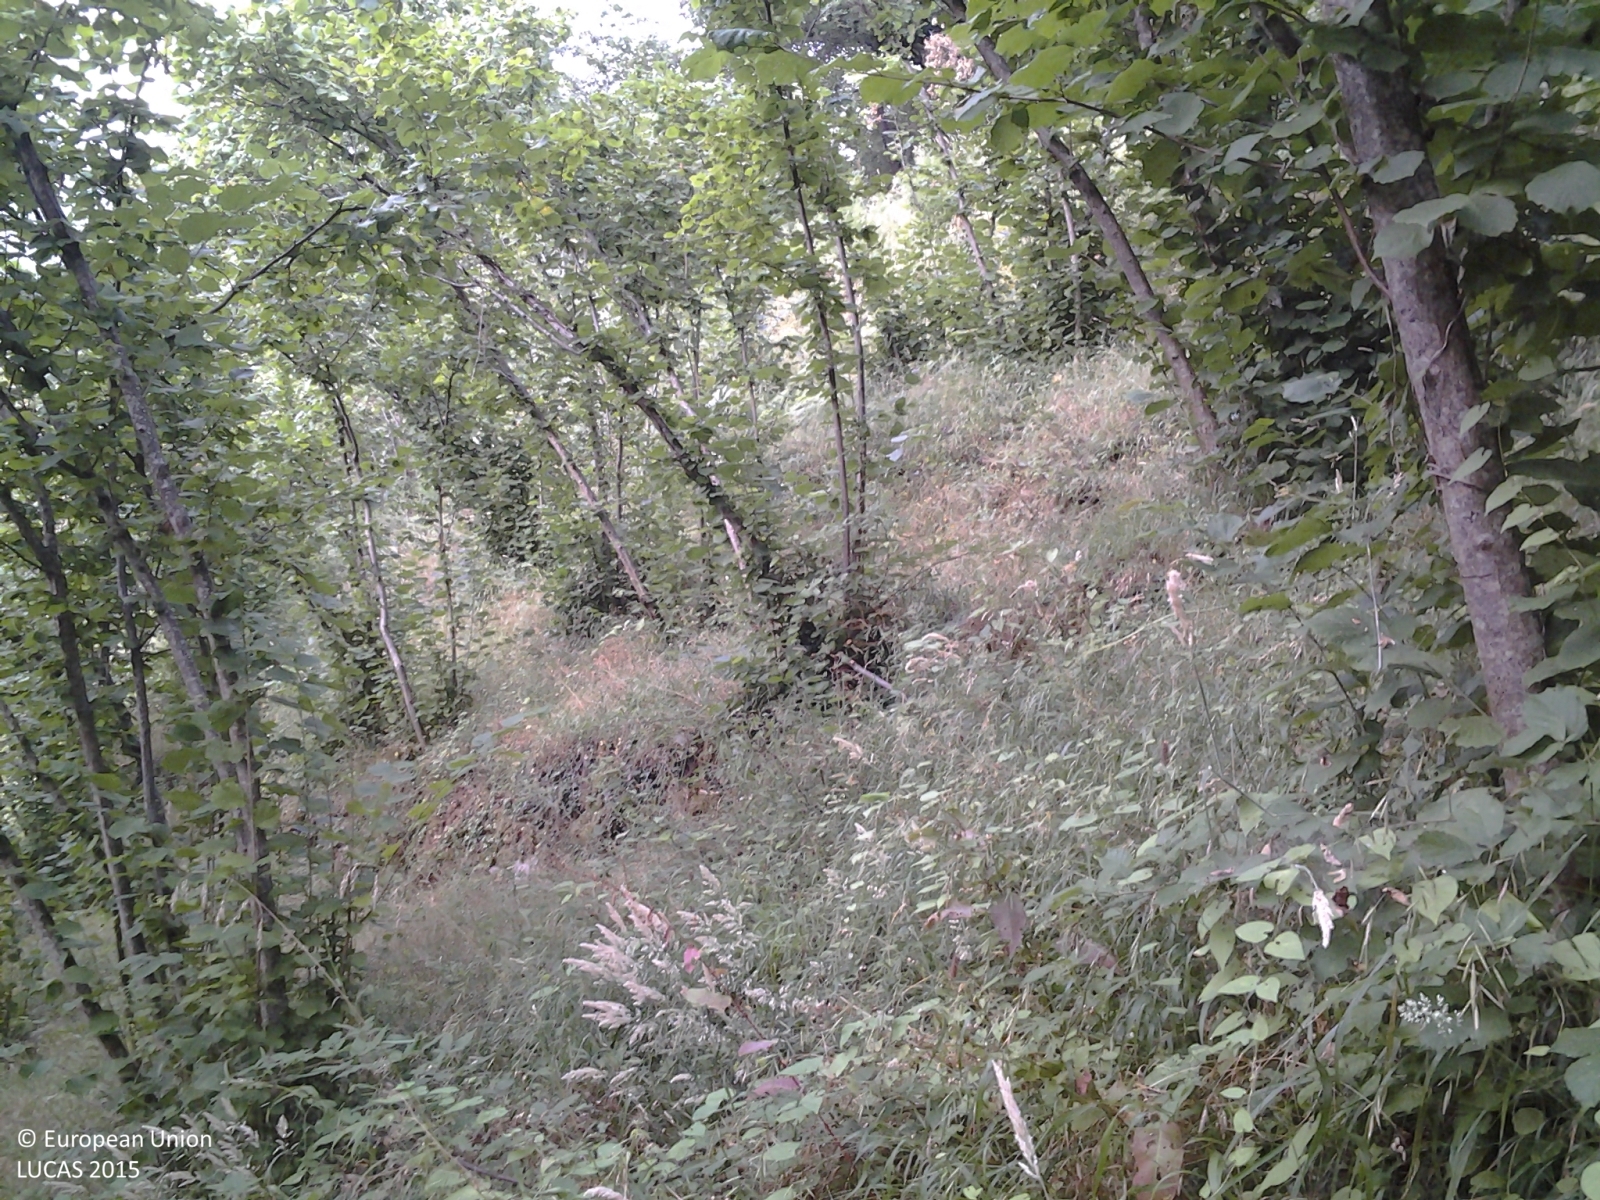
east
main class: Cropland
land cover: Nuts trees
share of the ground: > 75 %
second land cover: Spontaneously vegetated surfaces
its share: > 75 %
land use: Agriculture (excluding fallow land and kitchen gardens)
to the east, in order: Nuts trees; Spontaneously vegetated surfaces; Rivers and streams; Nuts trees; Broadleaved woodland; Nuts trees; Fences; Paved roads, cycling and walking lanes
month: July
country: IT
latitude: 38.0585
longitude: 14.8797
